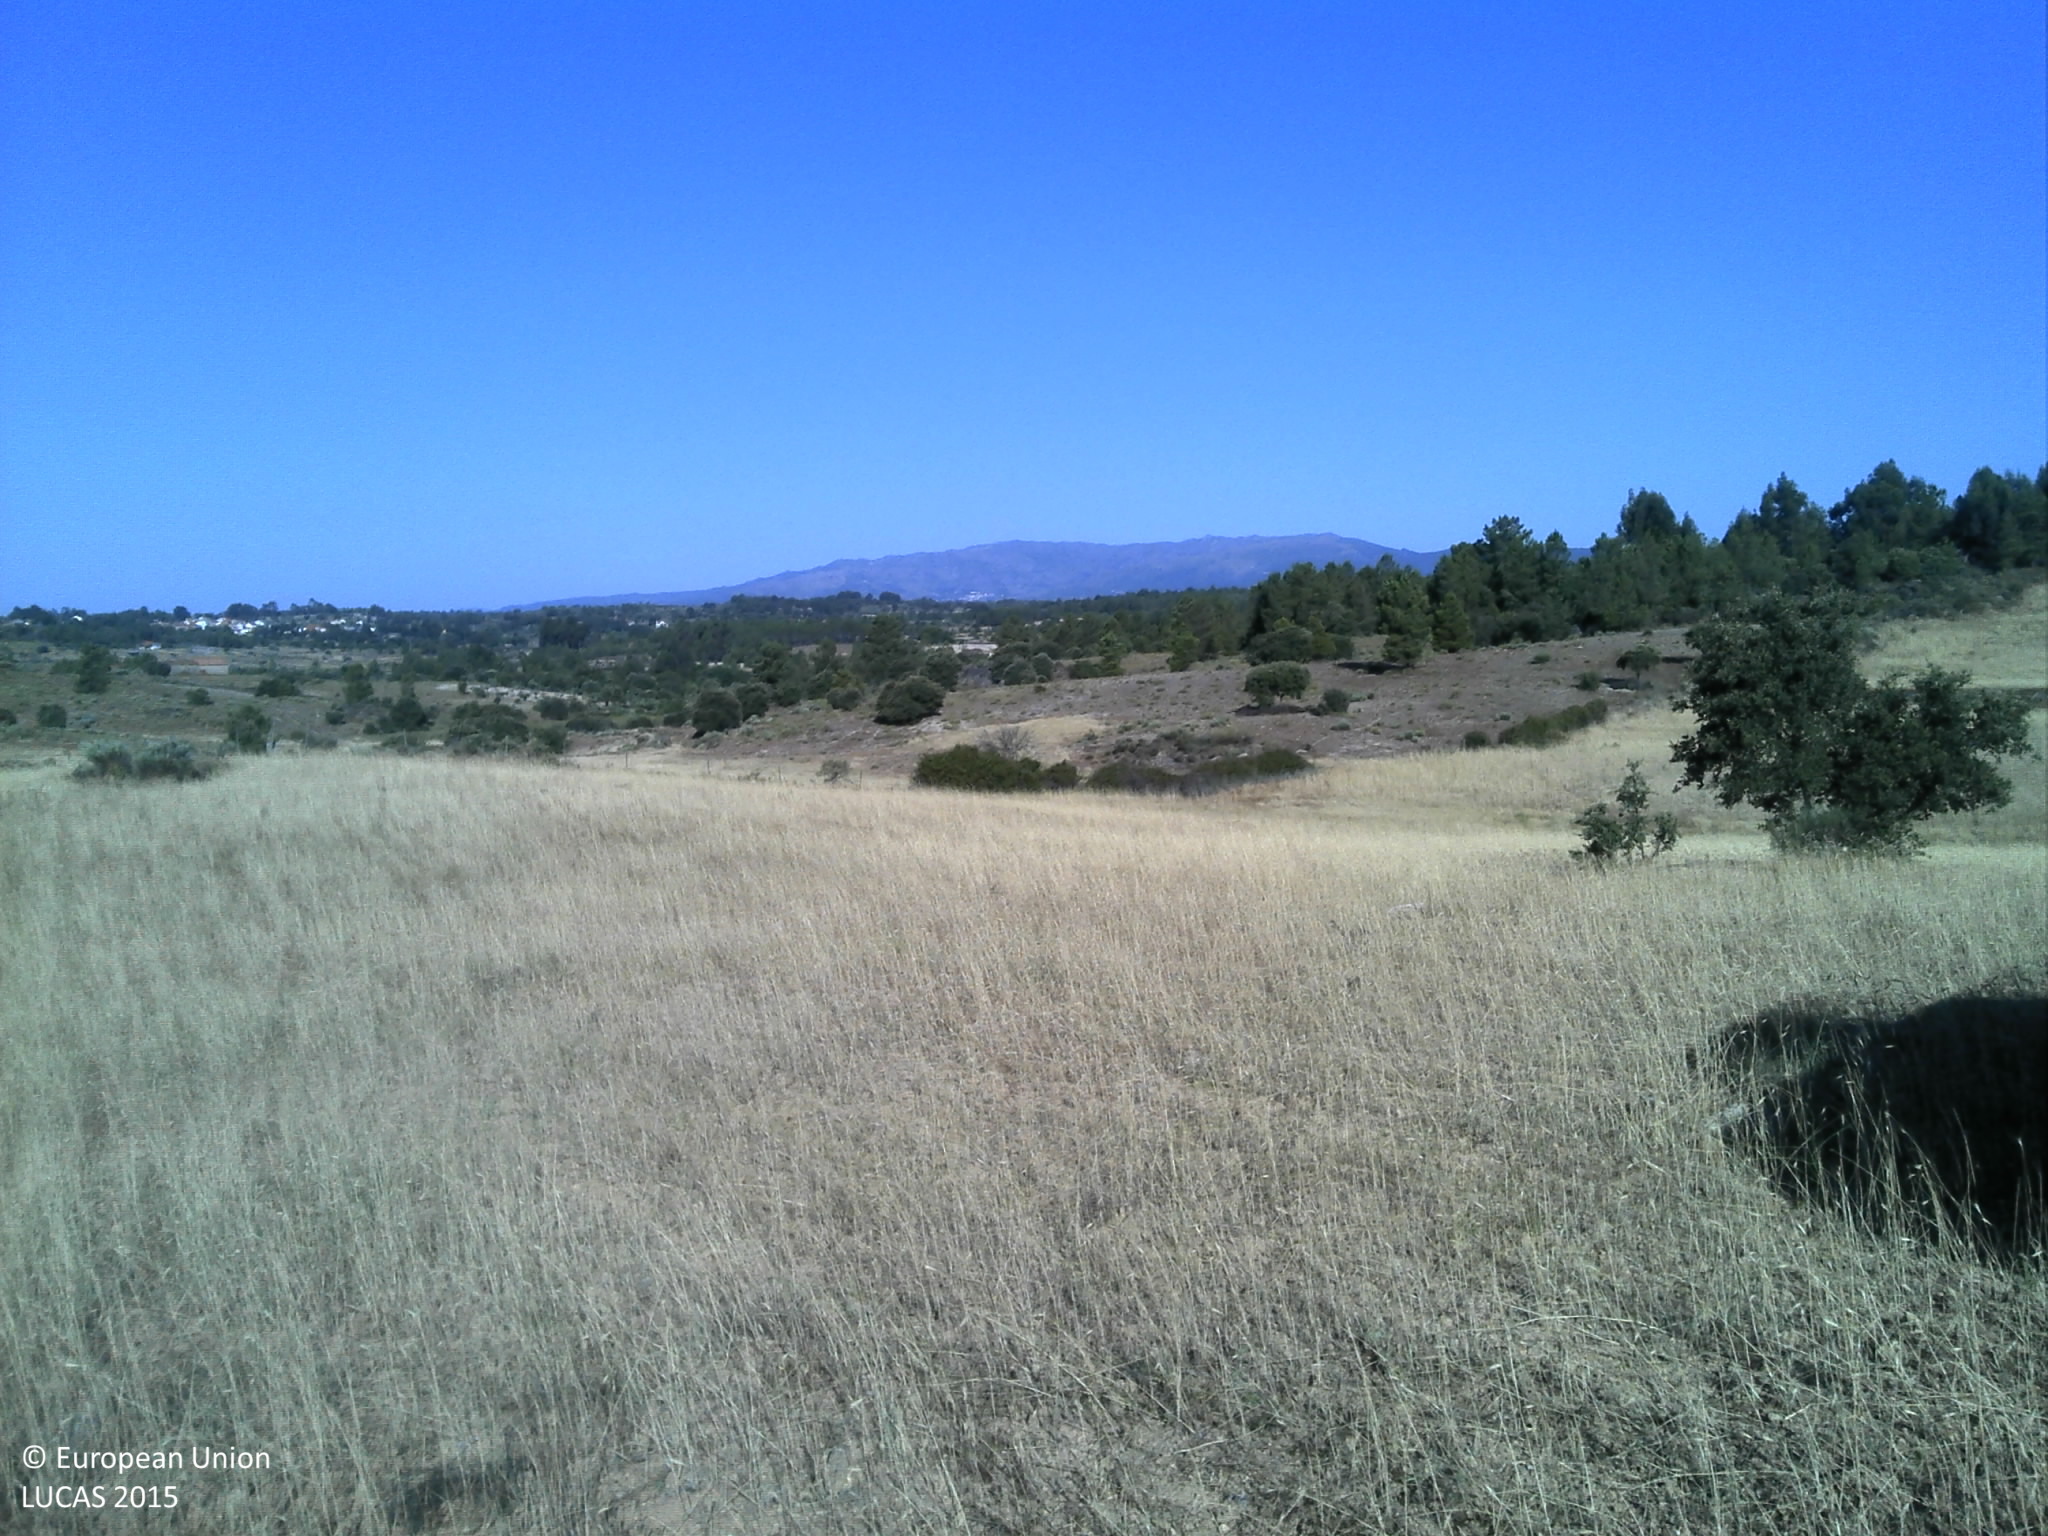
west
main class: Grassland
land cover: Grassland with sparse tree/shrub cover
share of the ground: 25 - 50 %
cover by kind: herbaceous plants 45 %, unconsolidated bare surface 40 %, shrubs 10 %, broadleaved forest trees 5 %
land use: Agriculture (excluding fallow land and kitchen gardens)
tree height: < 5 m
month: June
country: PT
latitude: 40.0821
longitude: -7.3030
